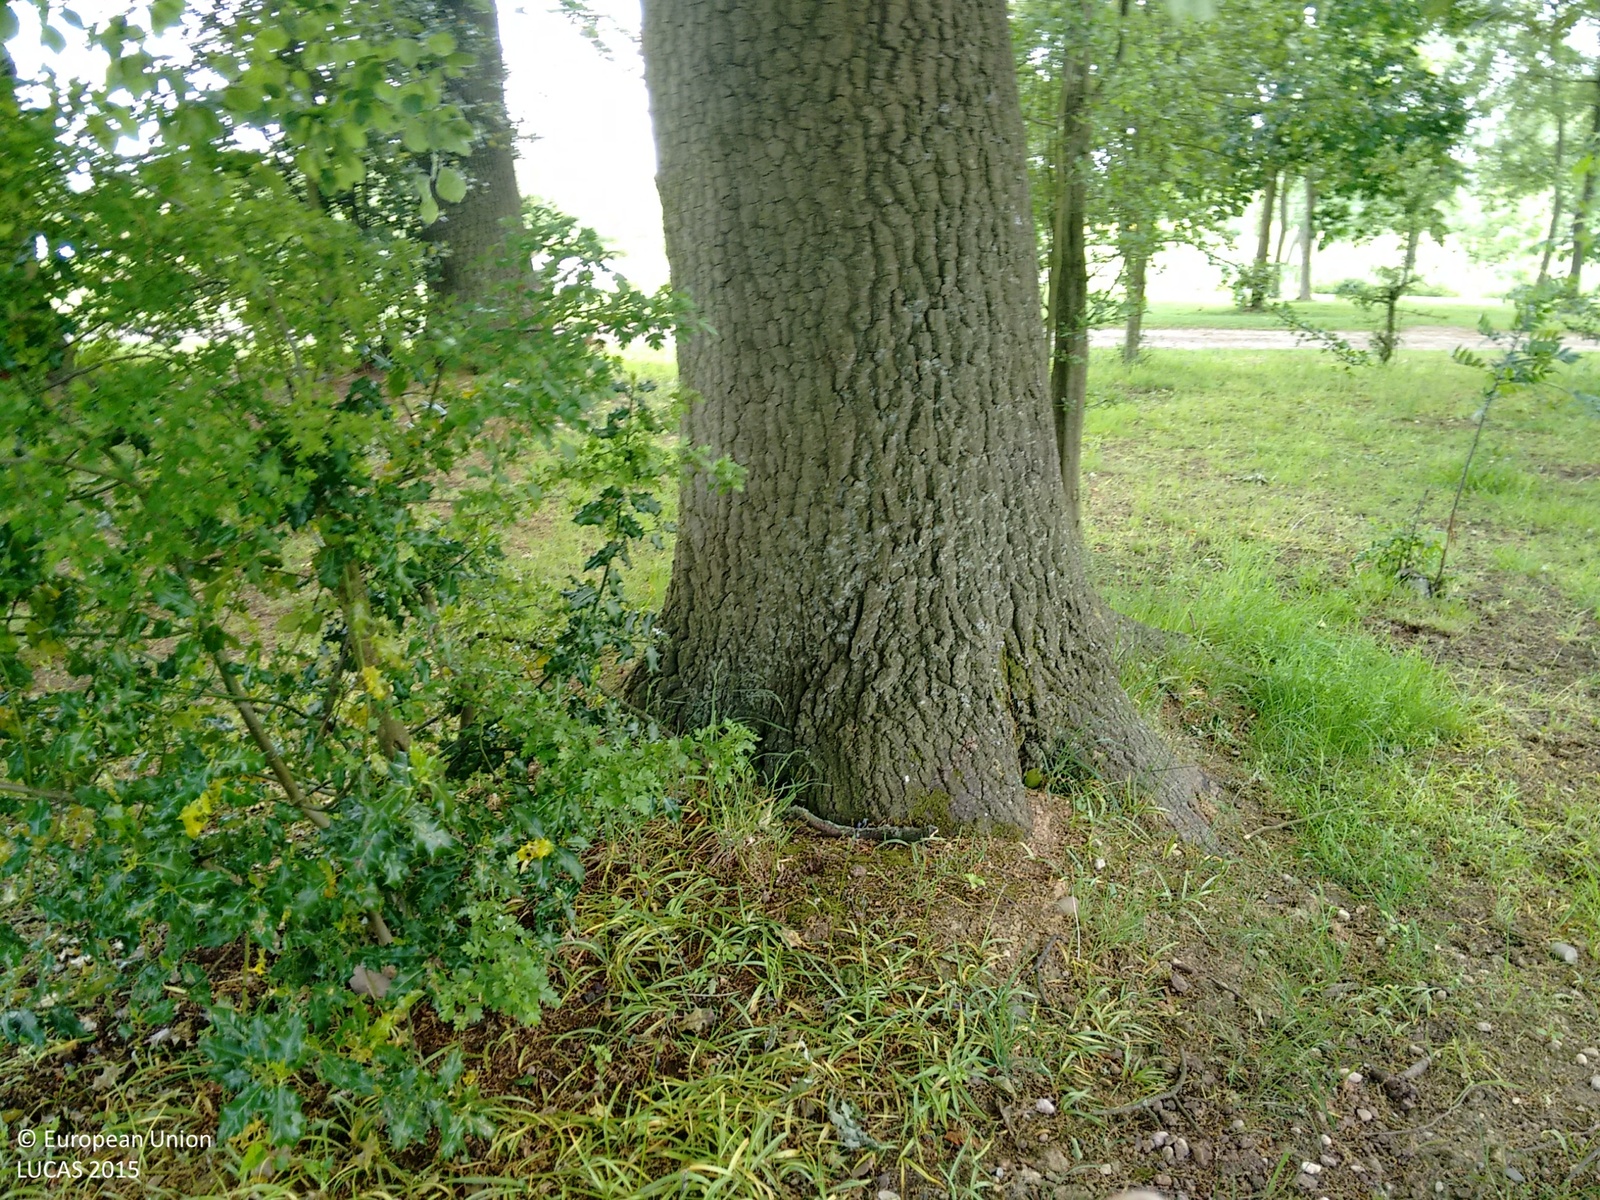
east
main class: Woodland
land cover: Broadleaved woodland
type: mesophytic deciduous forest
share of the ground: > 75 %
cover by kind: broadleaved forest trees 95 %, herbaceous plants 5 %
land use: Sport
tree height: > 5 m
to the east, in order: Broadleaved woodland; Tracks; Grassland without tree/shrub cover; Inland fresh water bodies; Grassland with sparse tree/shrub cover; Inland fresh water bodies; Grassland without tree/shrub cover; Grassland with sparse tree/shrub cover; Grassland without tree/shrub cover; Grassland with sparse tree/shrub cover; Ditches and canals; Managed hedges; Fences; Grassland without tree/shrub cover
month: June
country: GB
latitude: 52.2864
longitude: -1.7085
